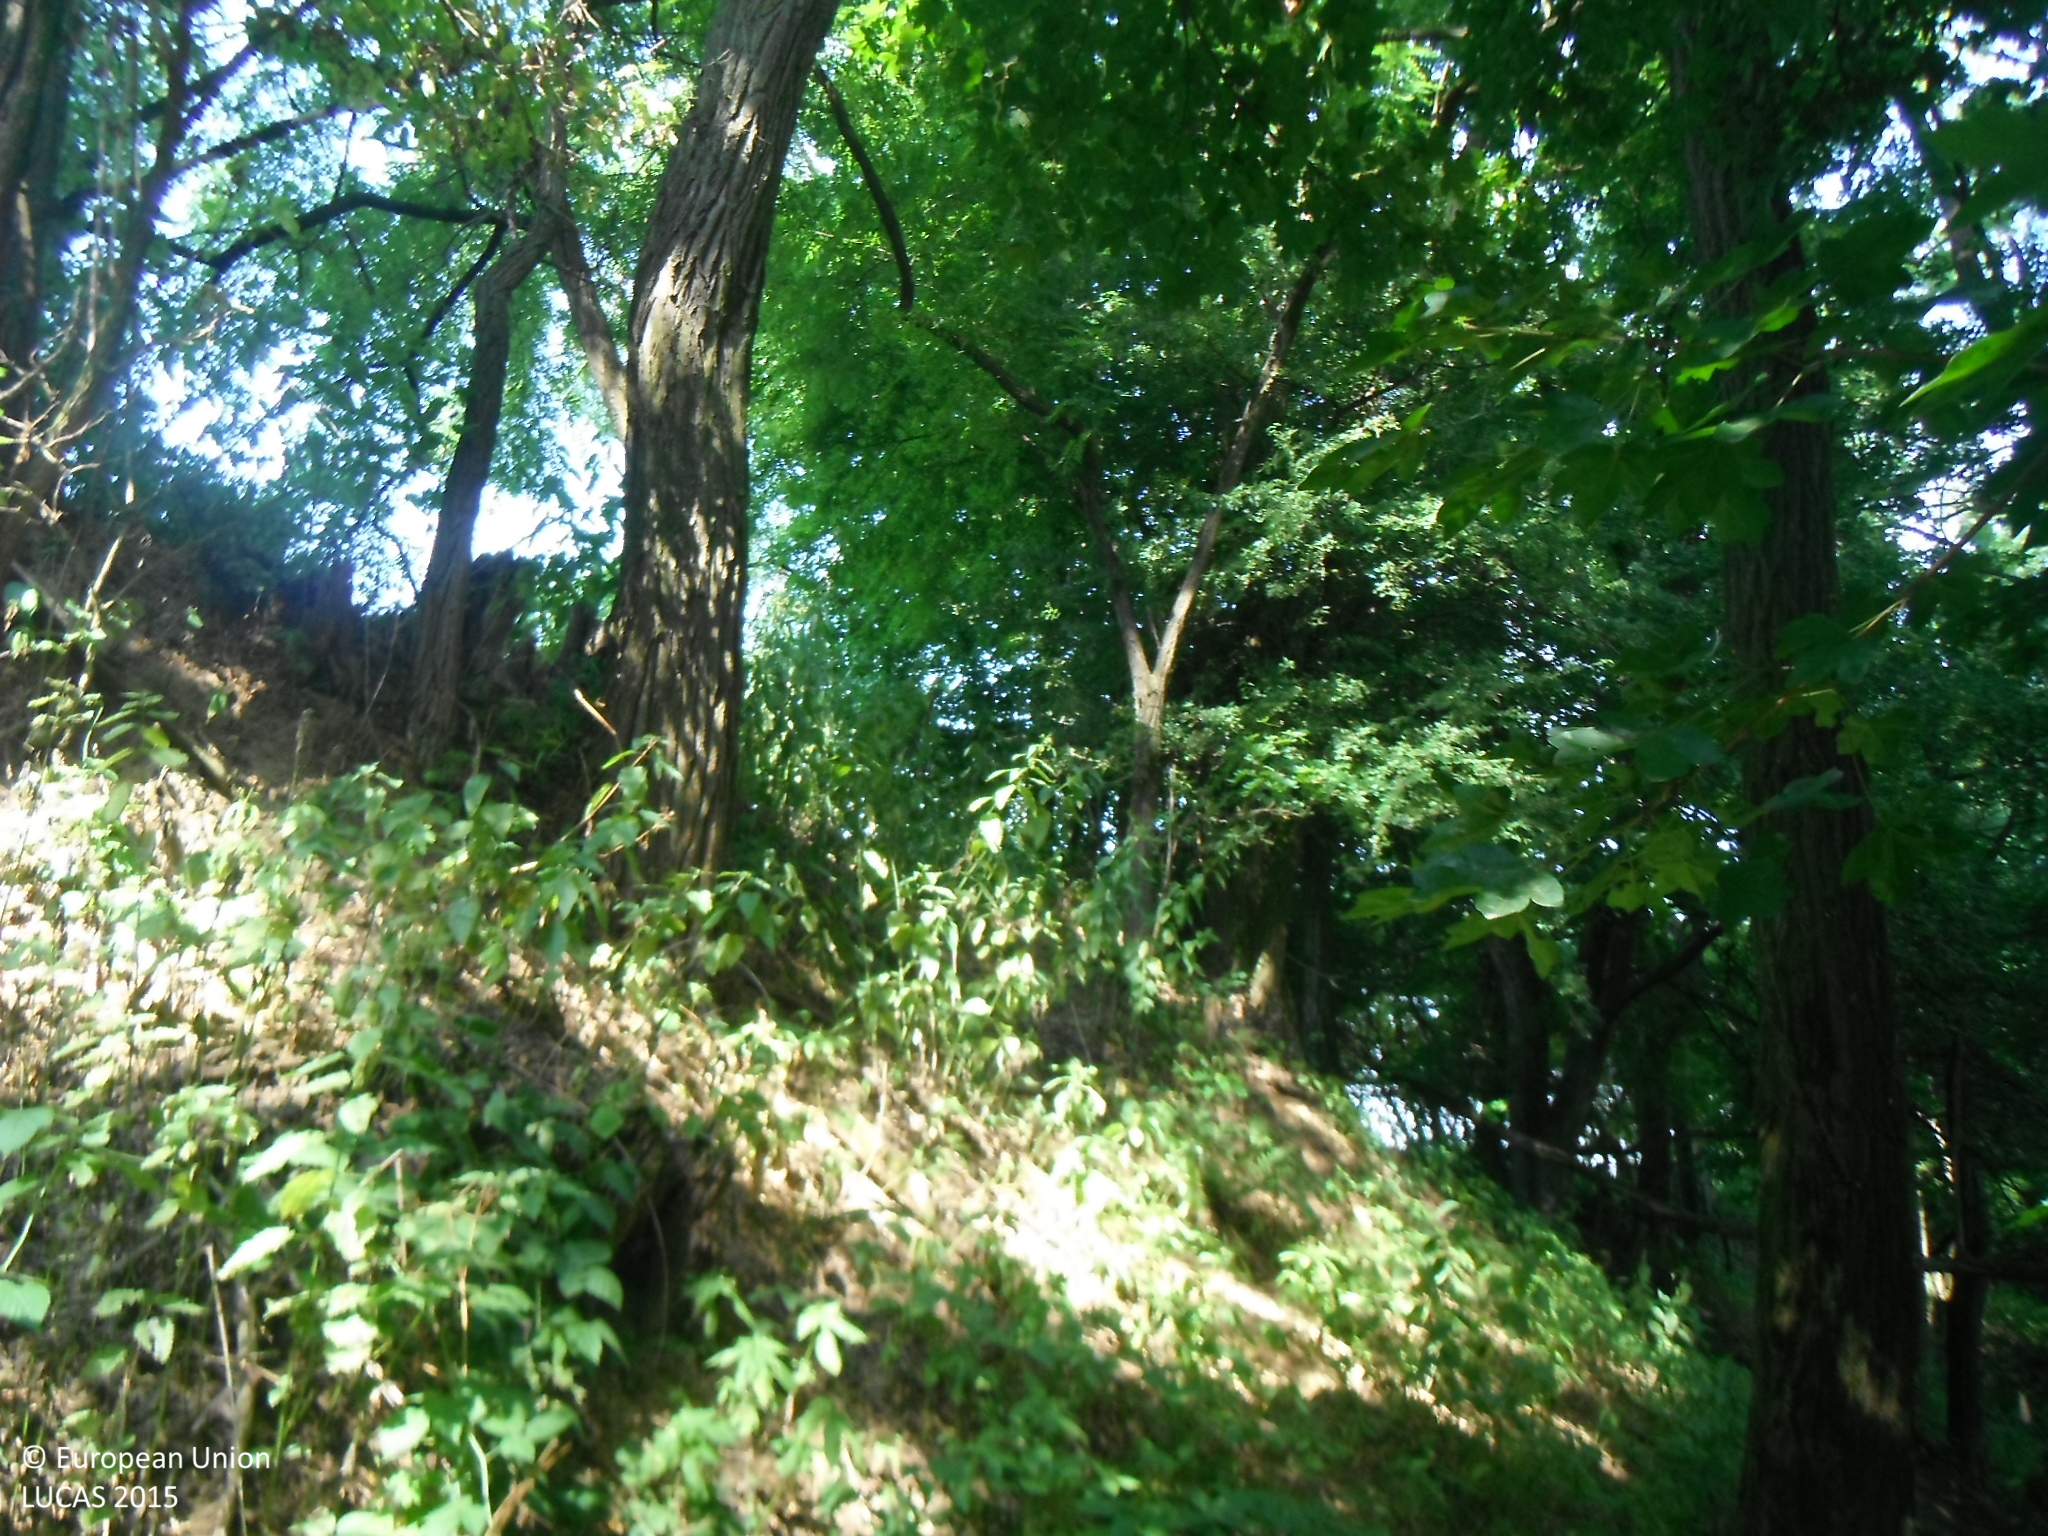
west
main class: Woodland
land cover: Broadleaved woodland
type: mesophytic deciduous forest
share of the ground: > 75 %
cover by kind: broadleaved forest trees 90 %, shrubs 5 %, herbaceous plants 5 %
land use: Semi-natural and natural areas not in use
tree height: > 5 m
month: July
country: SK
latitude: 48.6391
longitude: 17.4611
